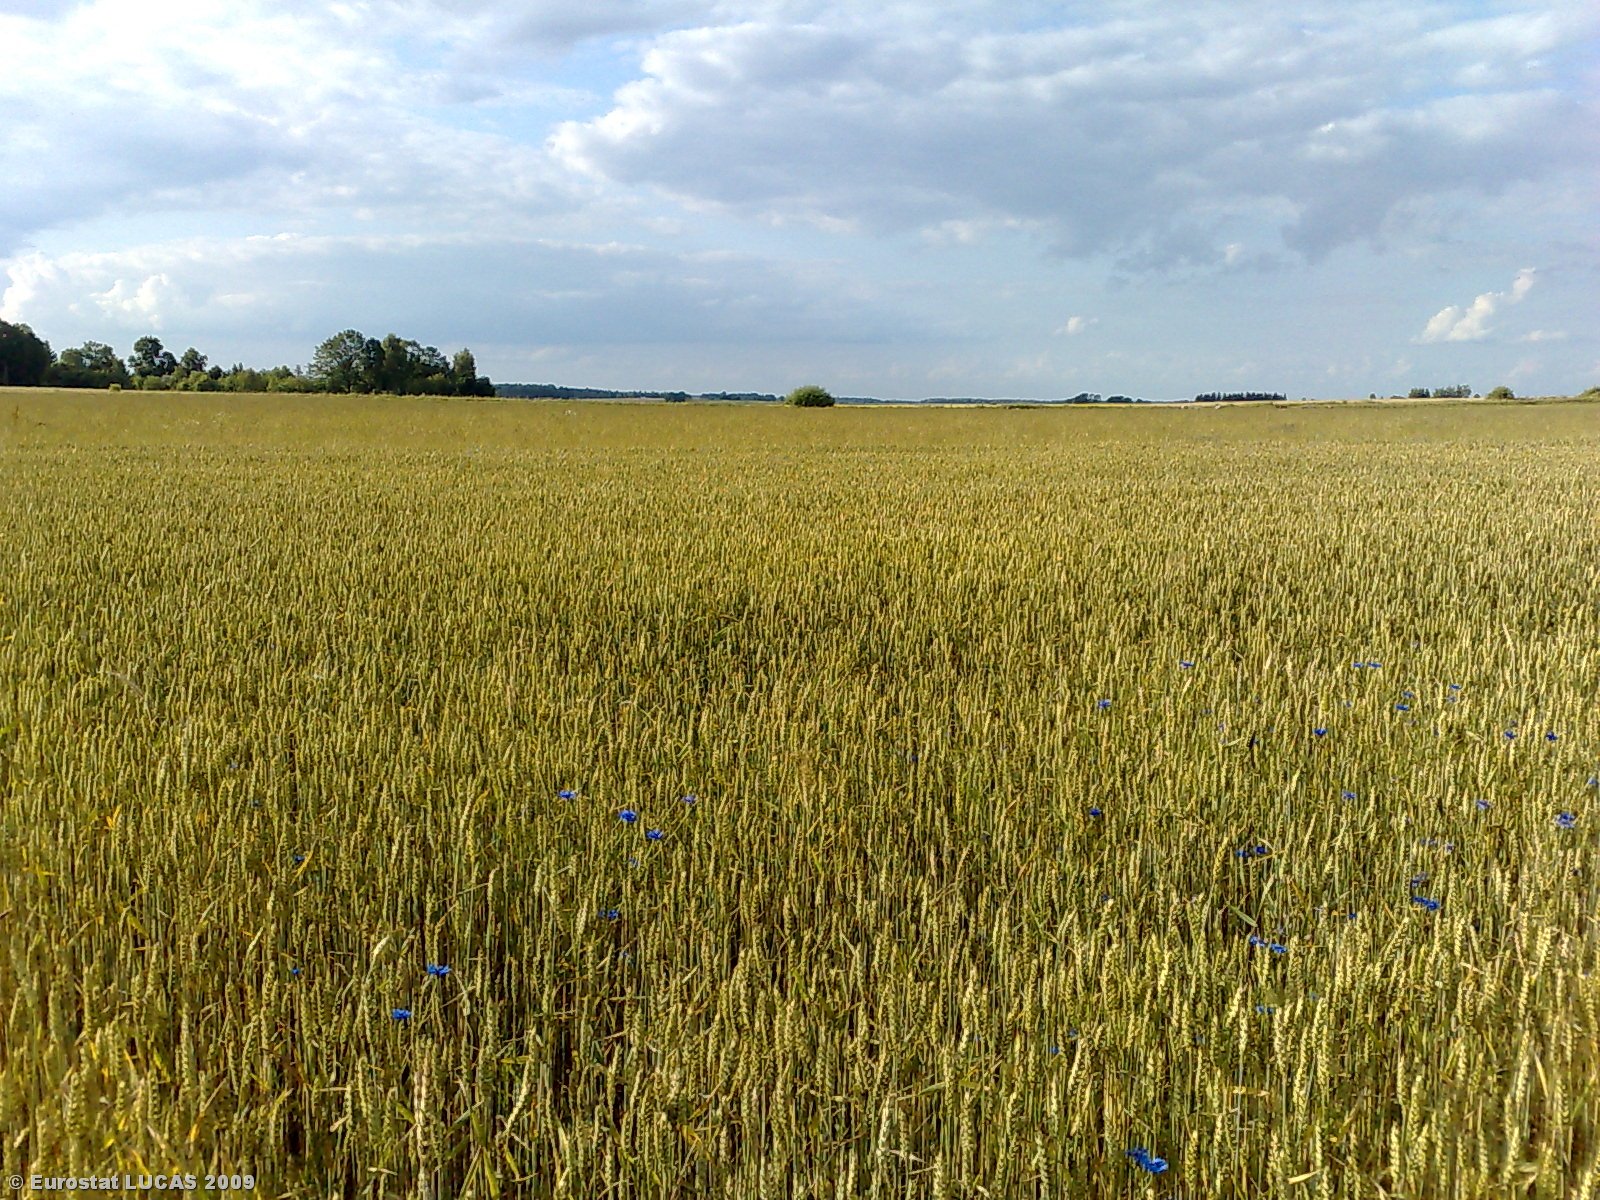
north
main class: Cropland
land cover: Common wheat
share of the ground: > 75 %
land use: Agriculture (excluding fallow land and kitchen gardens)
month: July
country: LT
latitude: 55.7414
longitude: 22.8243
